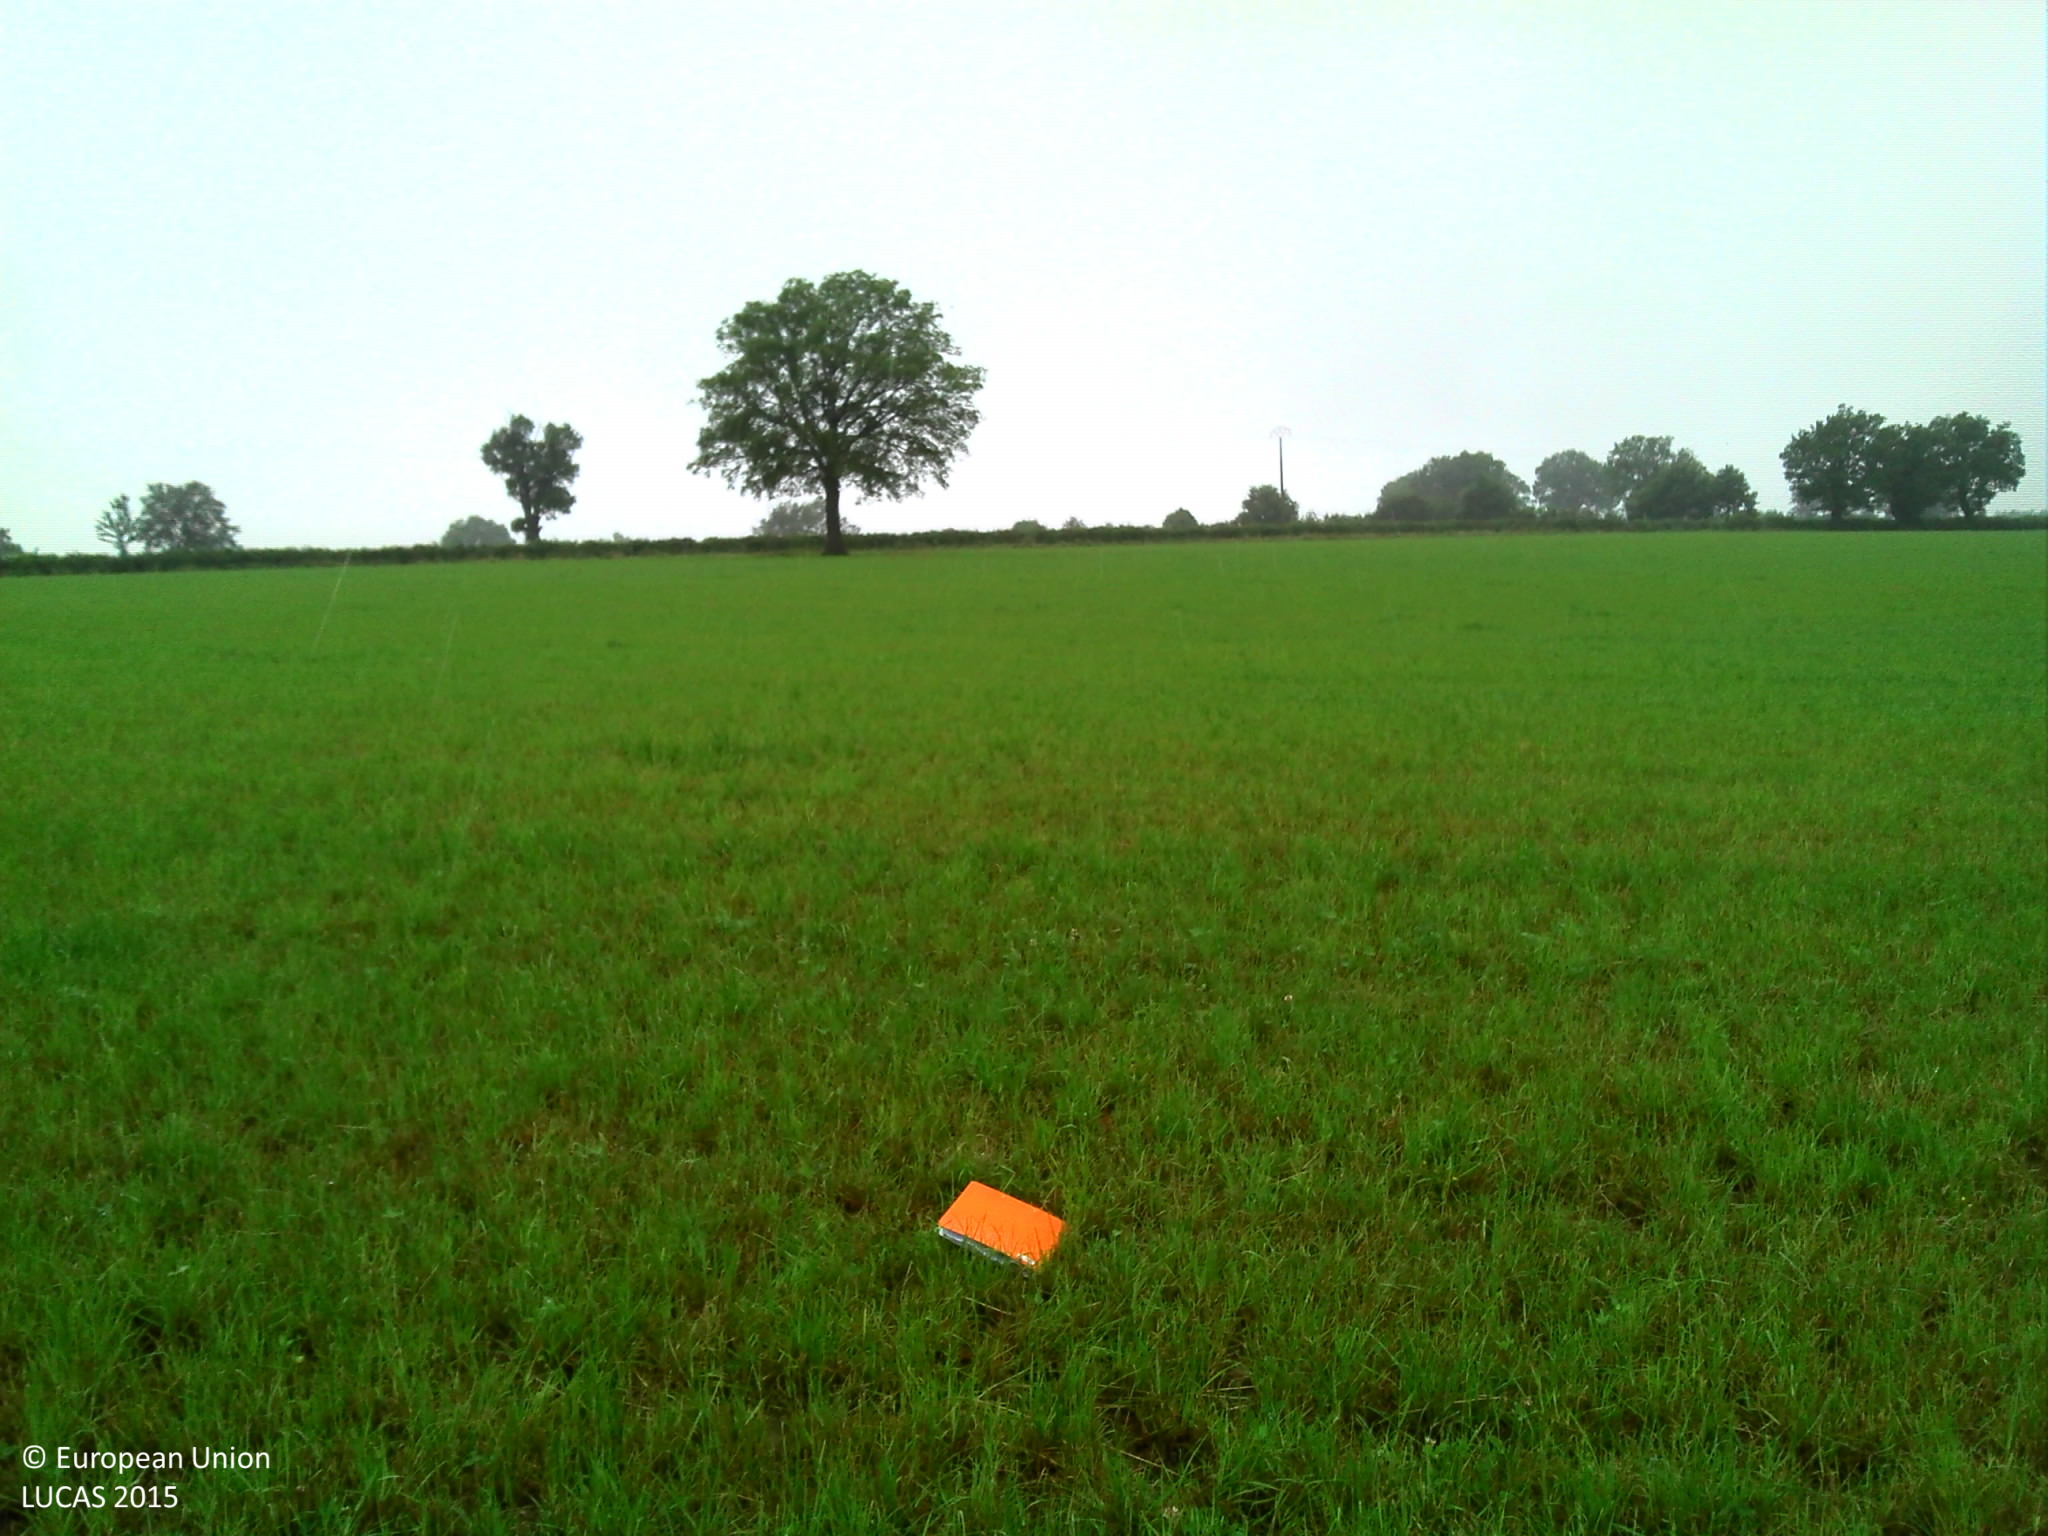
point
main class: Cropland
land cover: Temporary grasslands
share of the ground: > 75 %
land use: Agriculture (excluding fallow land and kitchen gardens)
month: June
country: FR
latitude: 46.4459
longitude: 2.9809
